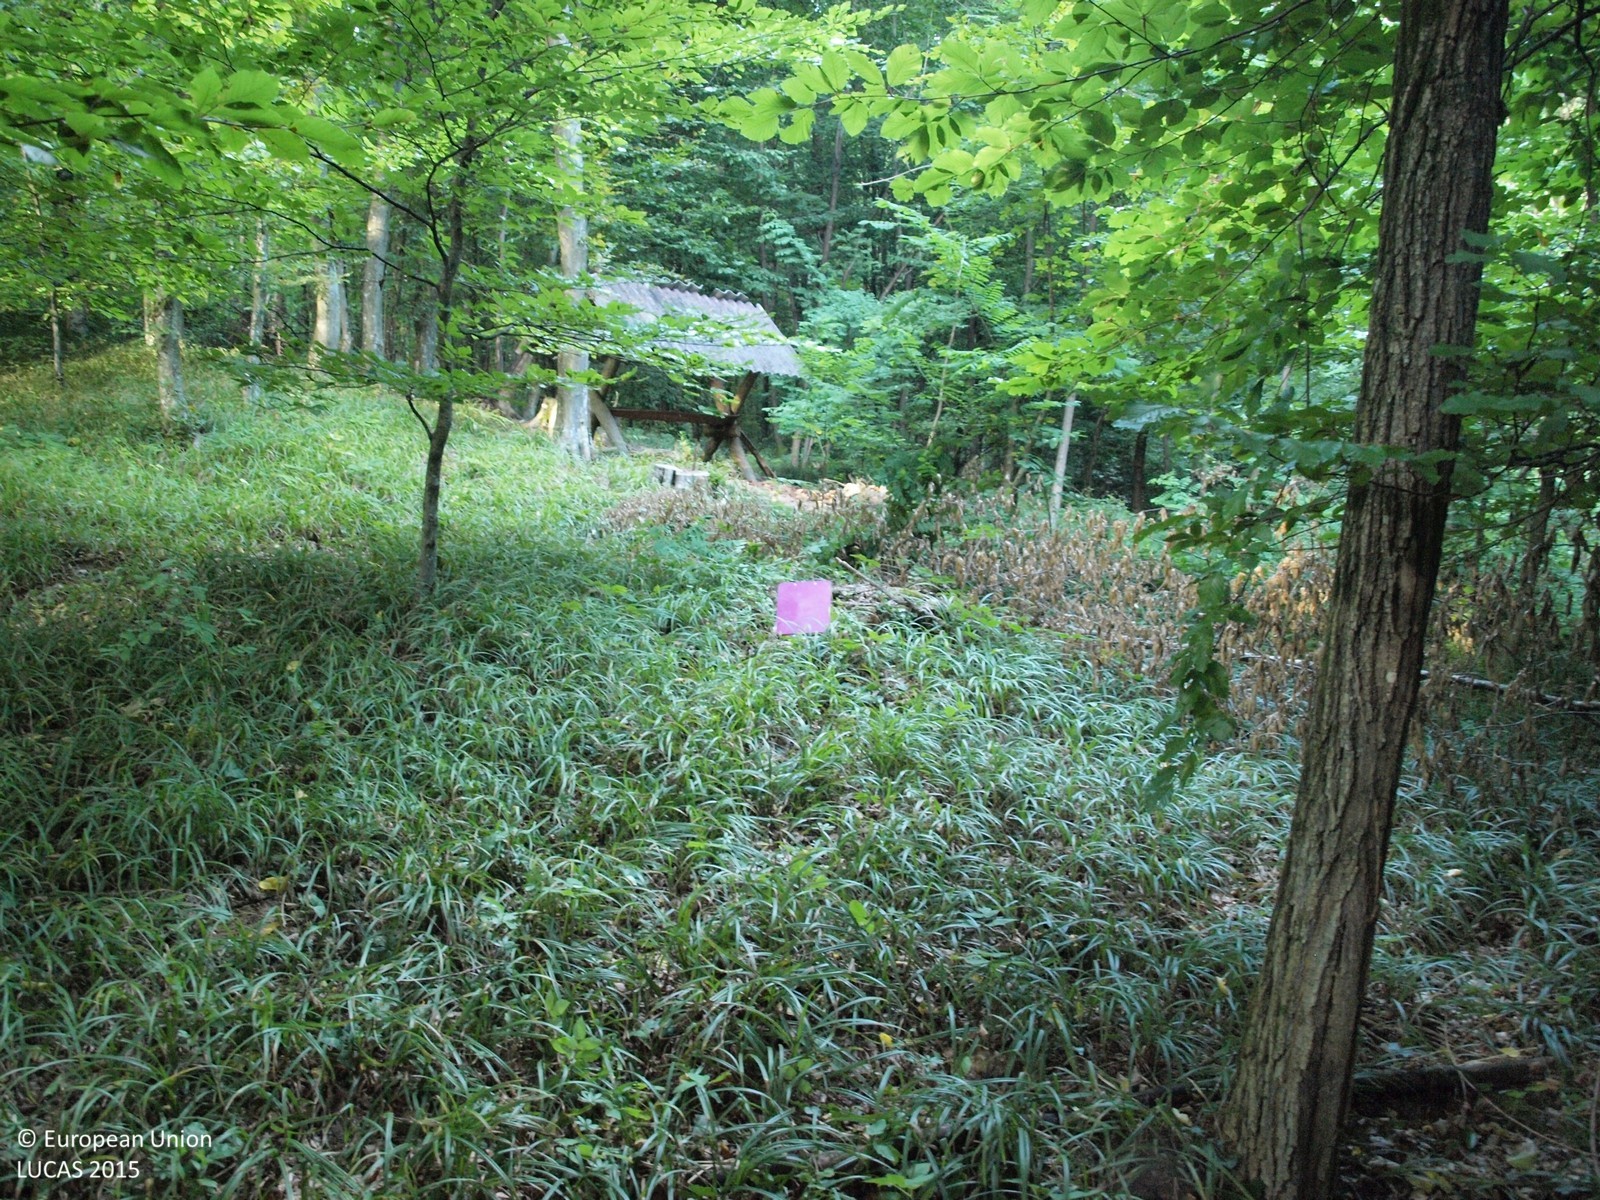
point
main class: Woodland
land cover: Broadleaved woodland
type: beech forest
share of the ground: > 75 %
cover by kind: broadleaved forest trees 100 %
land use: Forestry
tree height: > 5 m
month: August
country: HR
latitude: 46.0582
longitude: 16.5795
